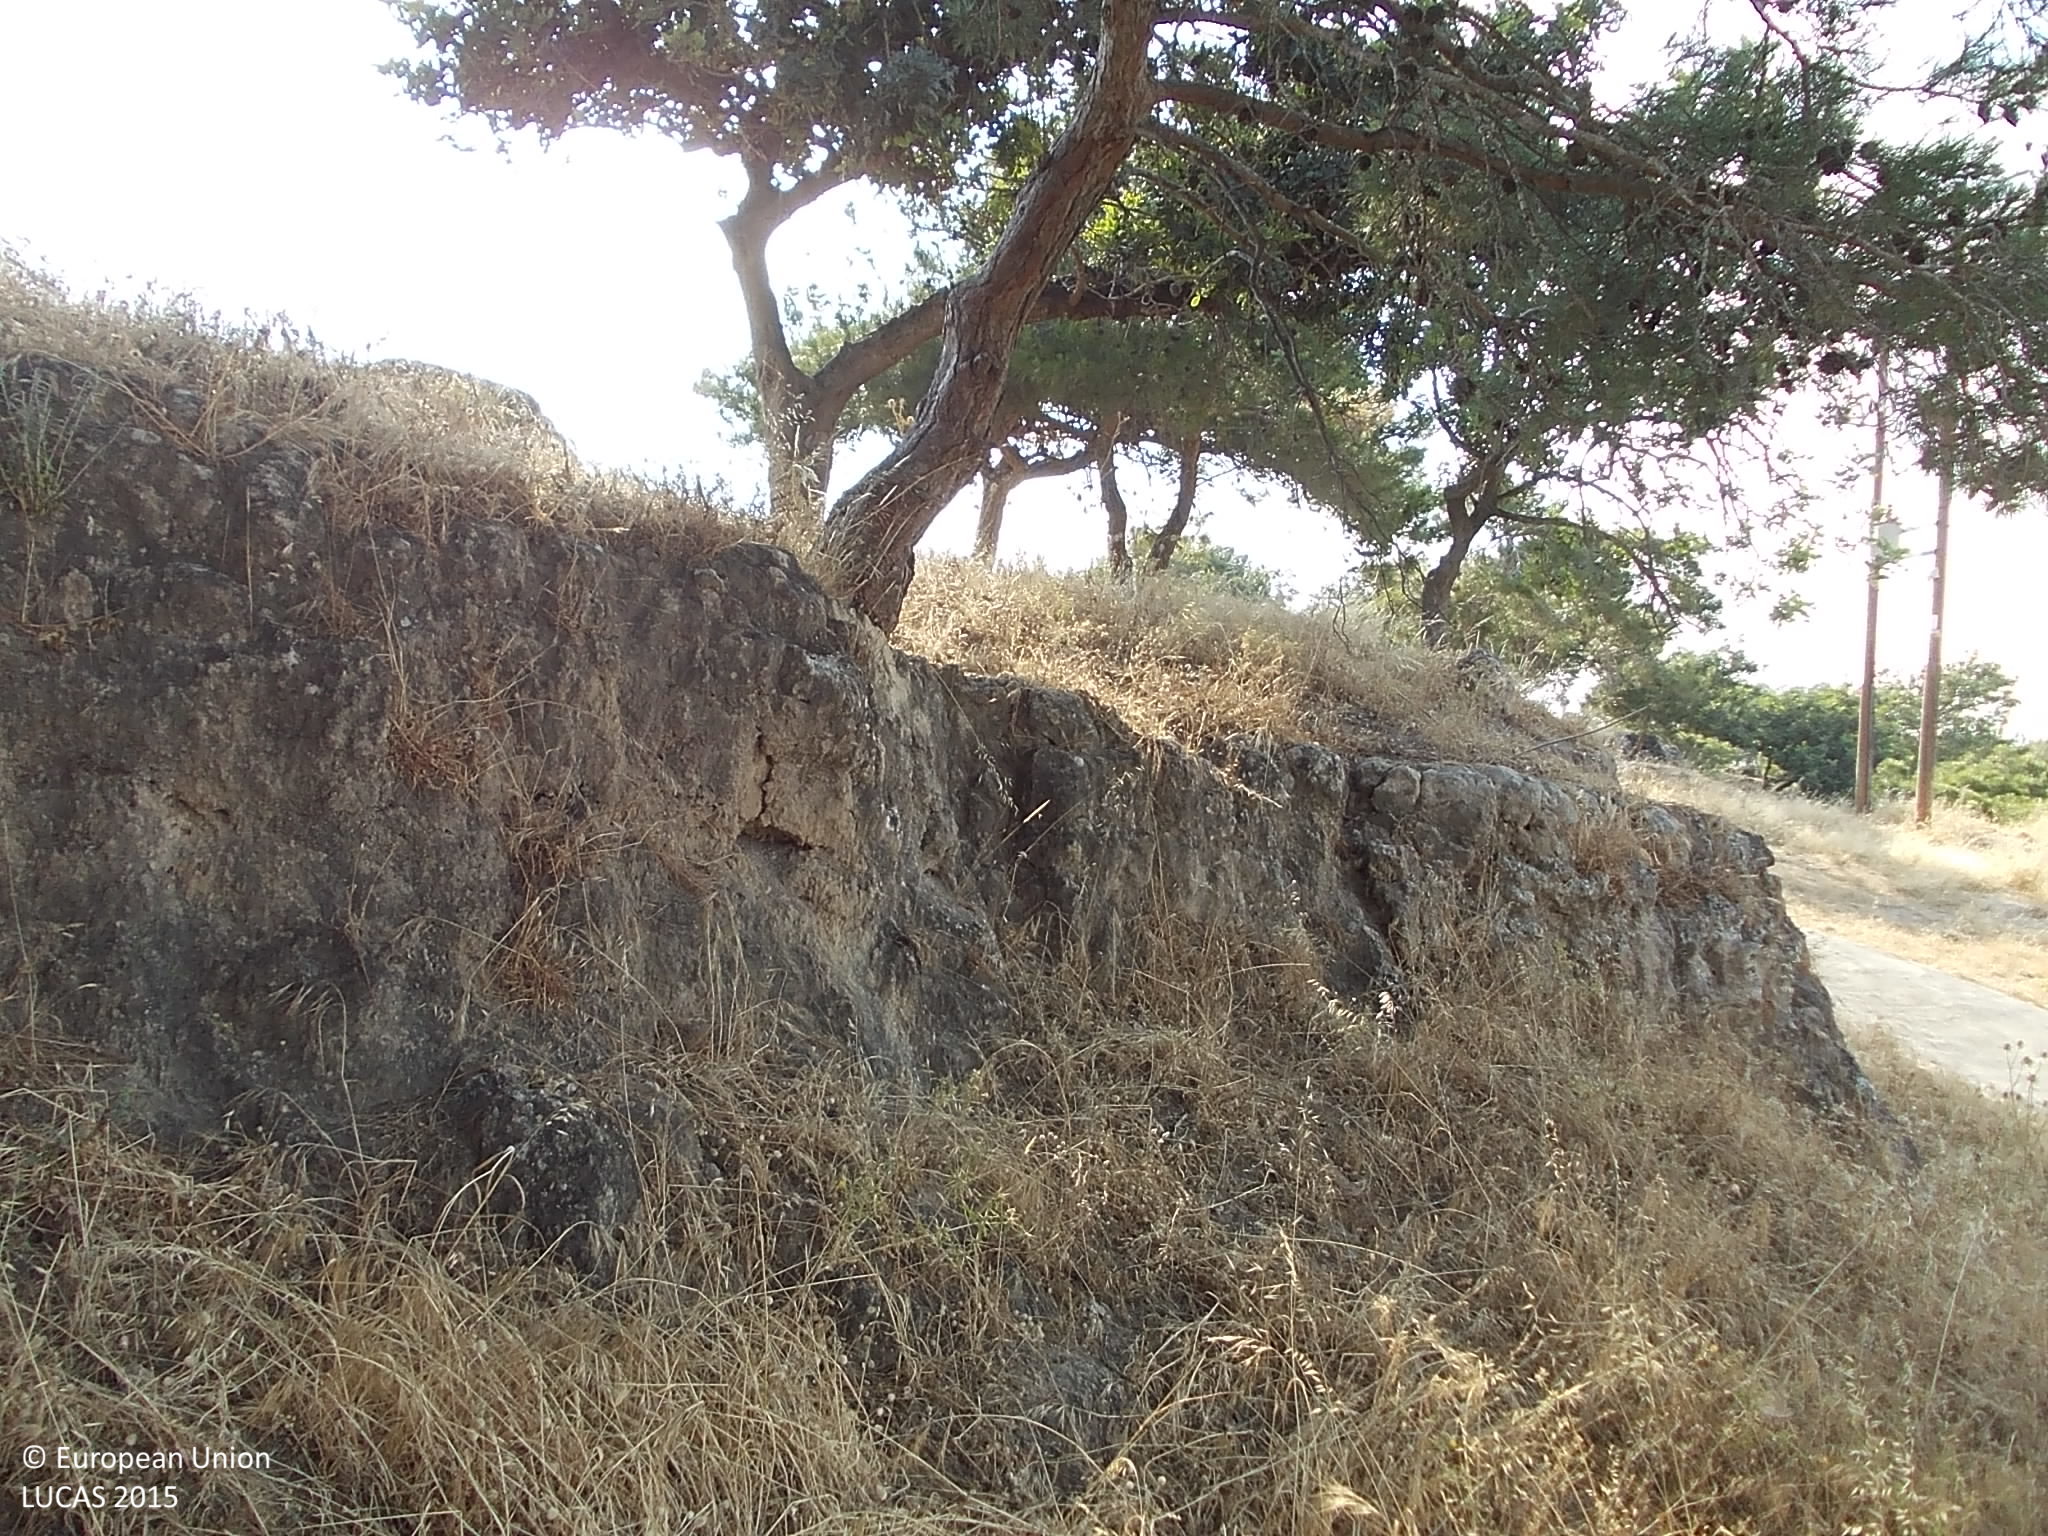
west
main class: Woodland
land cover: Pine dominated coniferous woodland
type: coniferous forest of the mediterranean region
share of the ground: 25 - 50 %
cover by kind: herbaceous plants 50 %, coniferous forest trees 35 %, consolidated bare surface 15 %
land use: Semi-natural and natural areas not in use
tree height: > 5 m
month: June
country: CY
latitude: 34.6676
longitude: 32.6857
